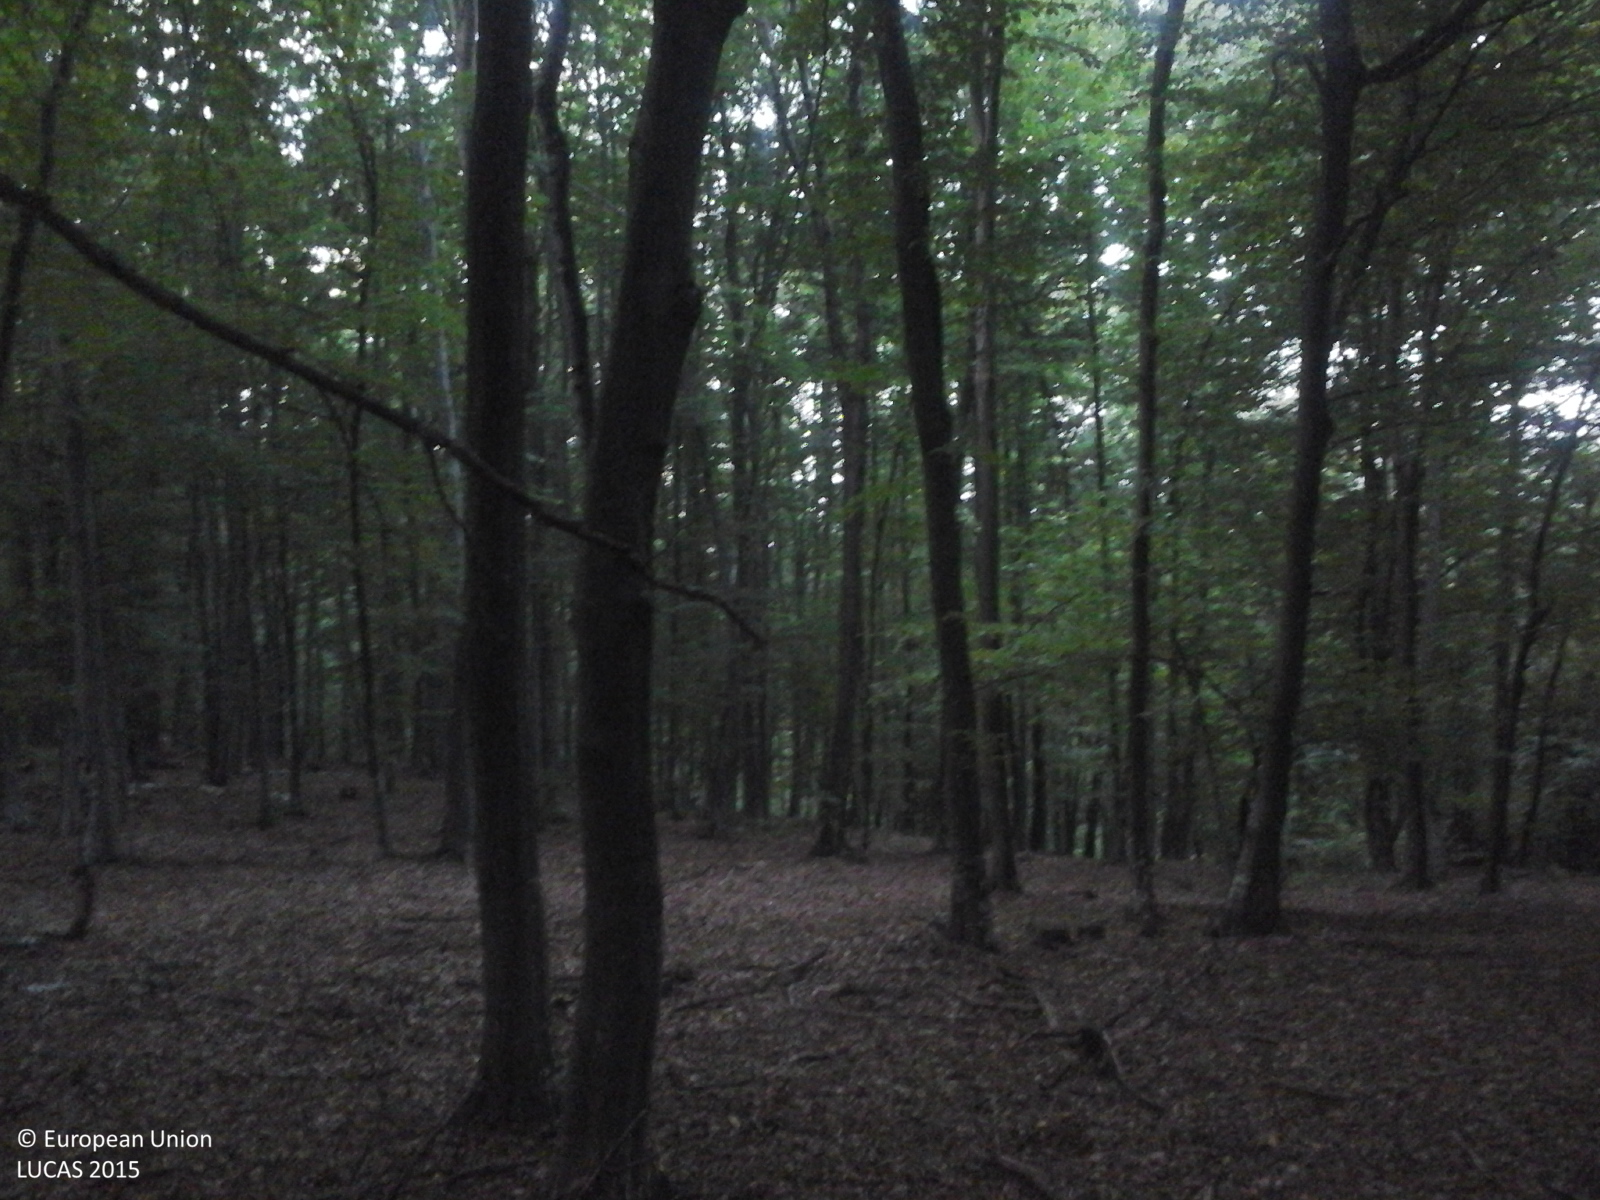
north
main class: Woodland
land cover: Broadleaved woodland
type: beech forest
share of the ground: > 75 %
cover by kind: broadleaved forest trees 100 %
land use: Forestry
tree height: > 5 m
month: September
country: RO
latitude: 47.1159
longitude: 22.5901
